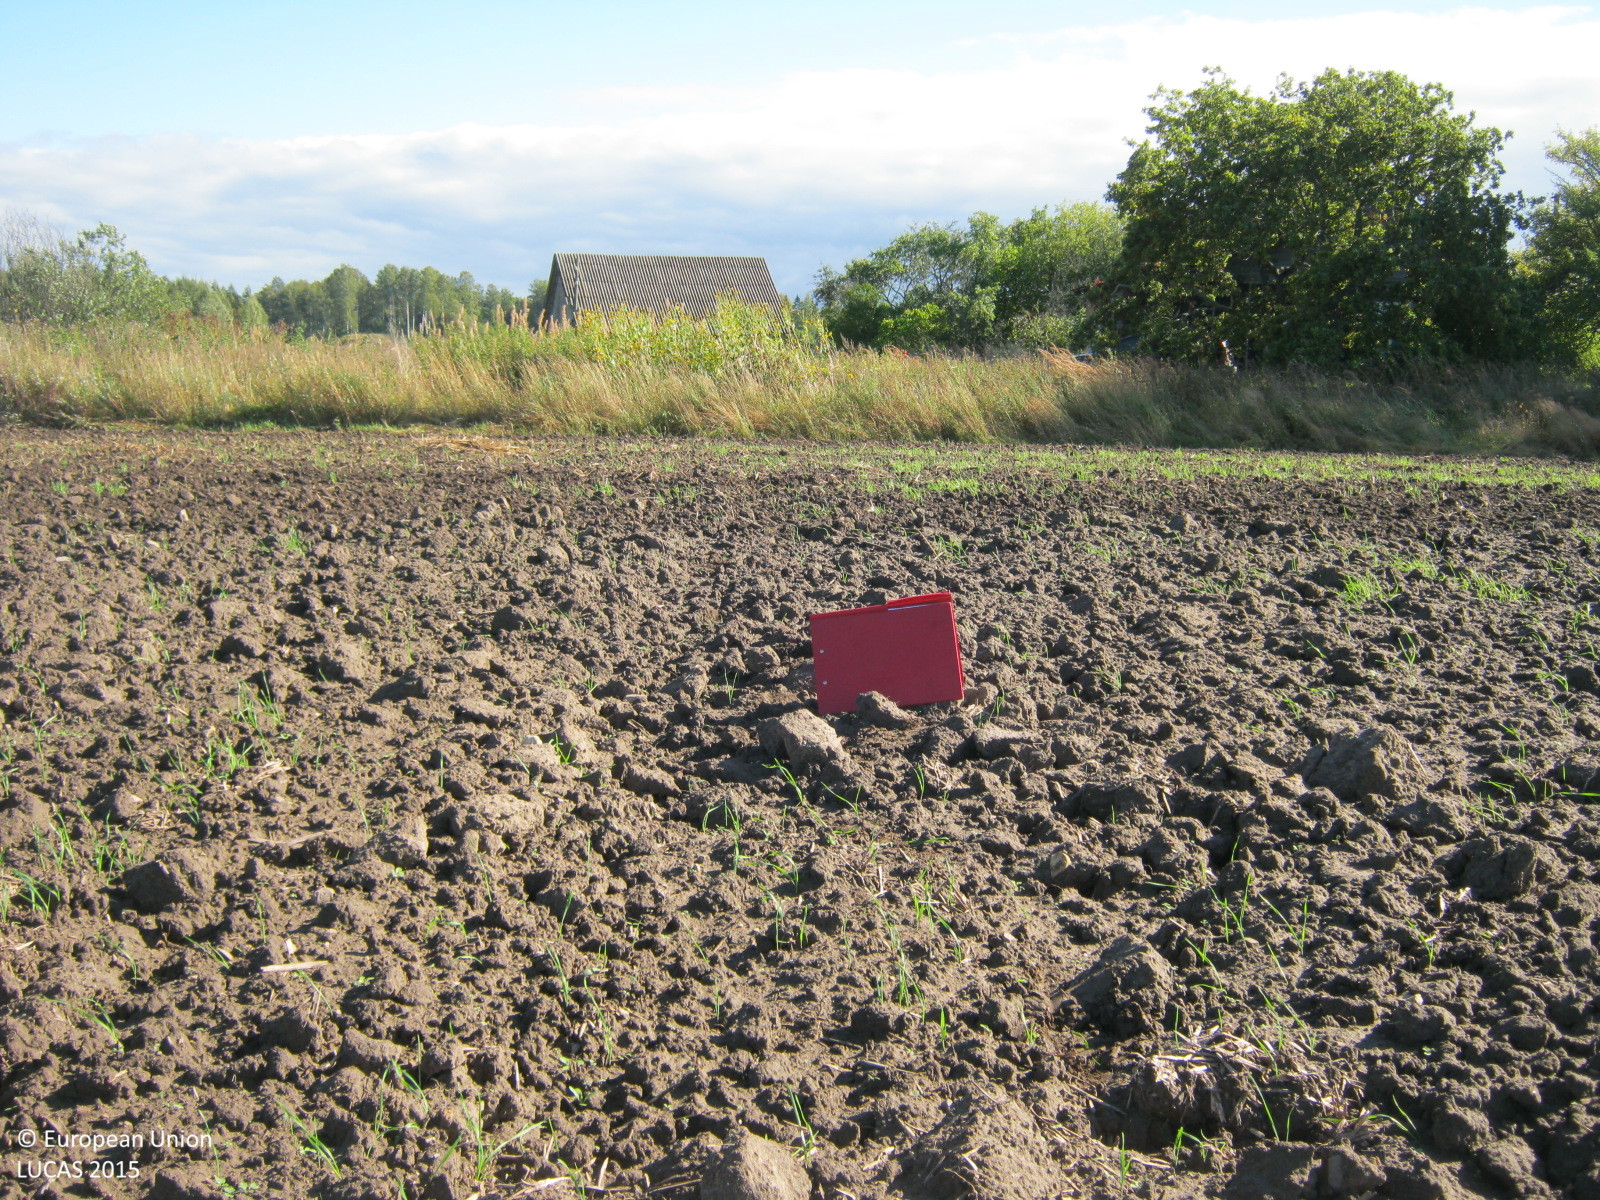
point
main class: Cropland
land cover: Common wheat
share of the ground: < 10 %
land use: Agriculture (excluding fallow land and kitchen gardens)
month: September
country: LV
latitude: 57.2761
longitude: 24.5393
